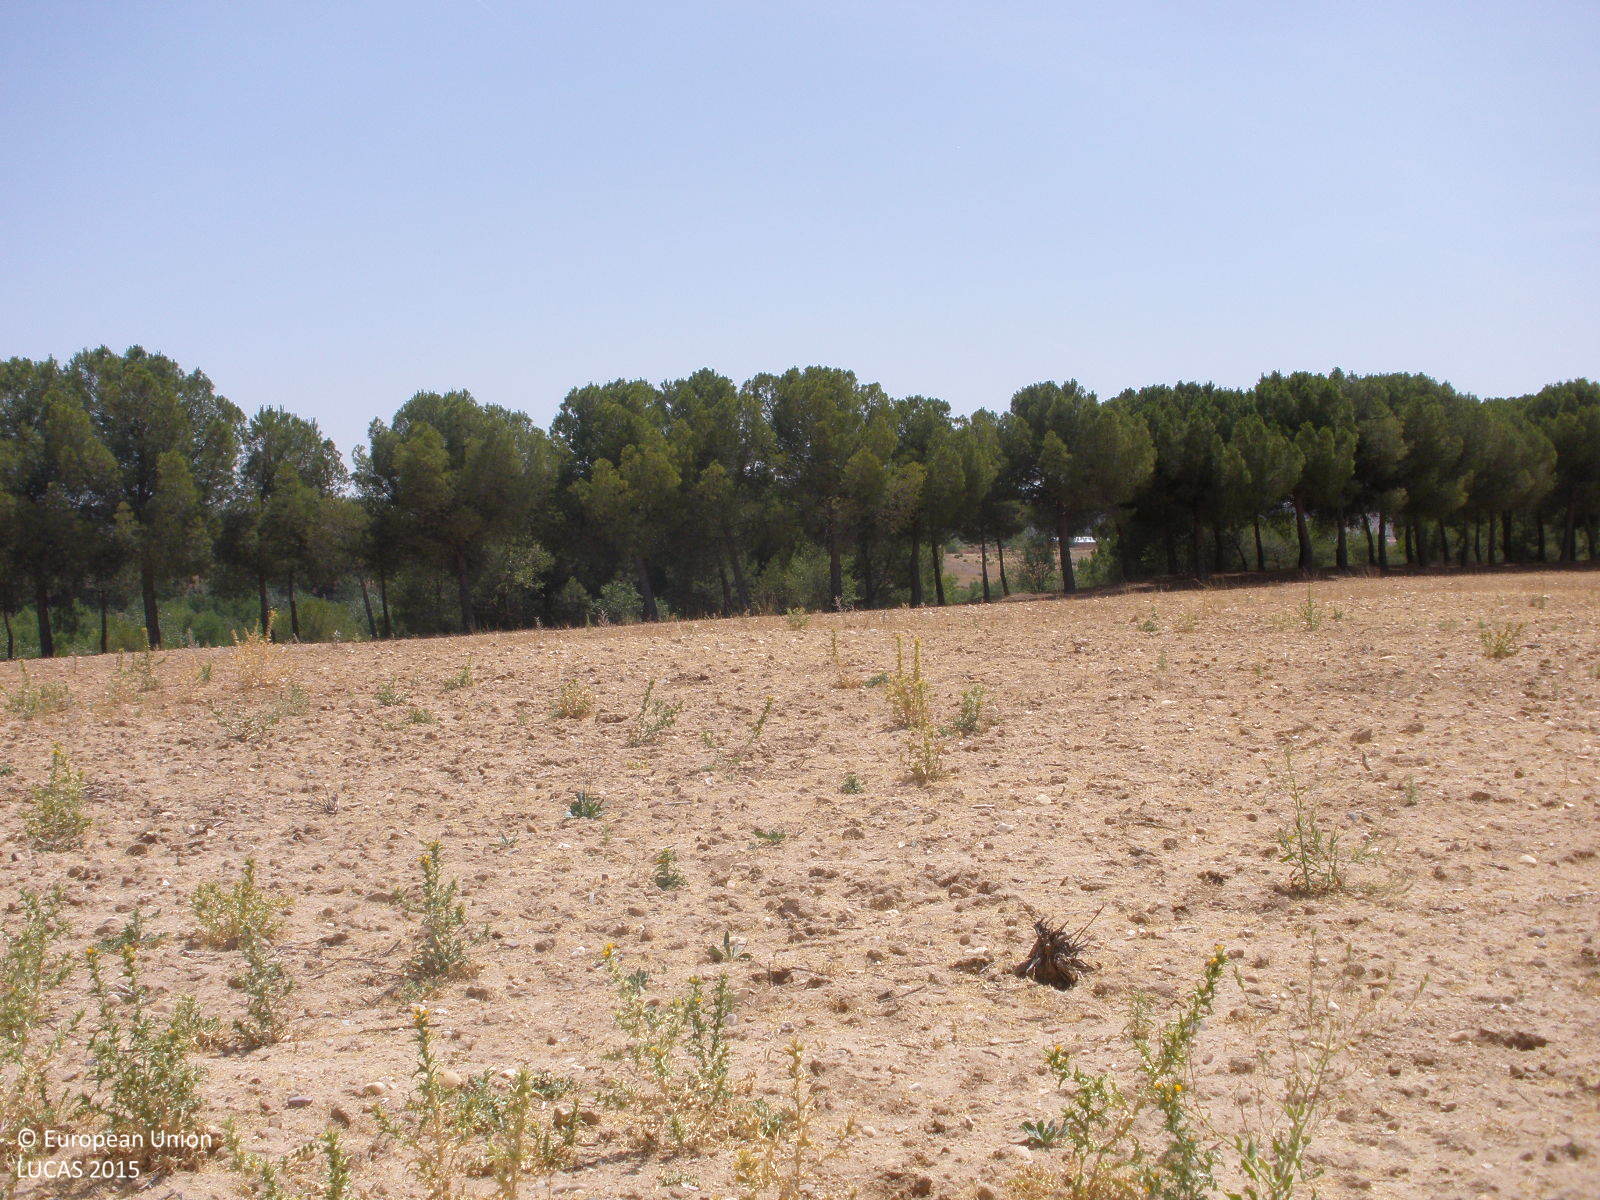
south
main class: Grassland
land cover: Spontaneously vegetated surfaces
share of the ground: 25 - 50 %
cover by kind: unconsolidated bare surface 70 %, herbaceous plants 30 %
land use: Semi-natural and natural areas not in use
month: July
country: ES
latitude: 40.2996
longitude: -3.5042
